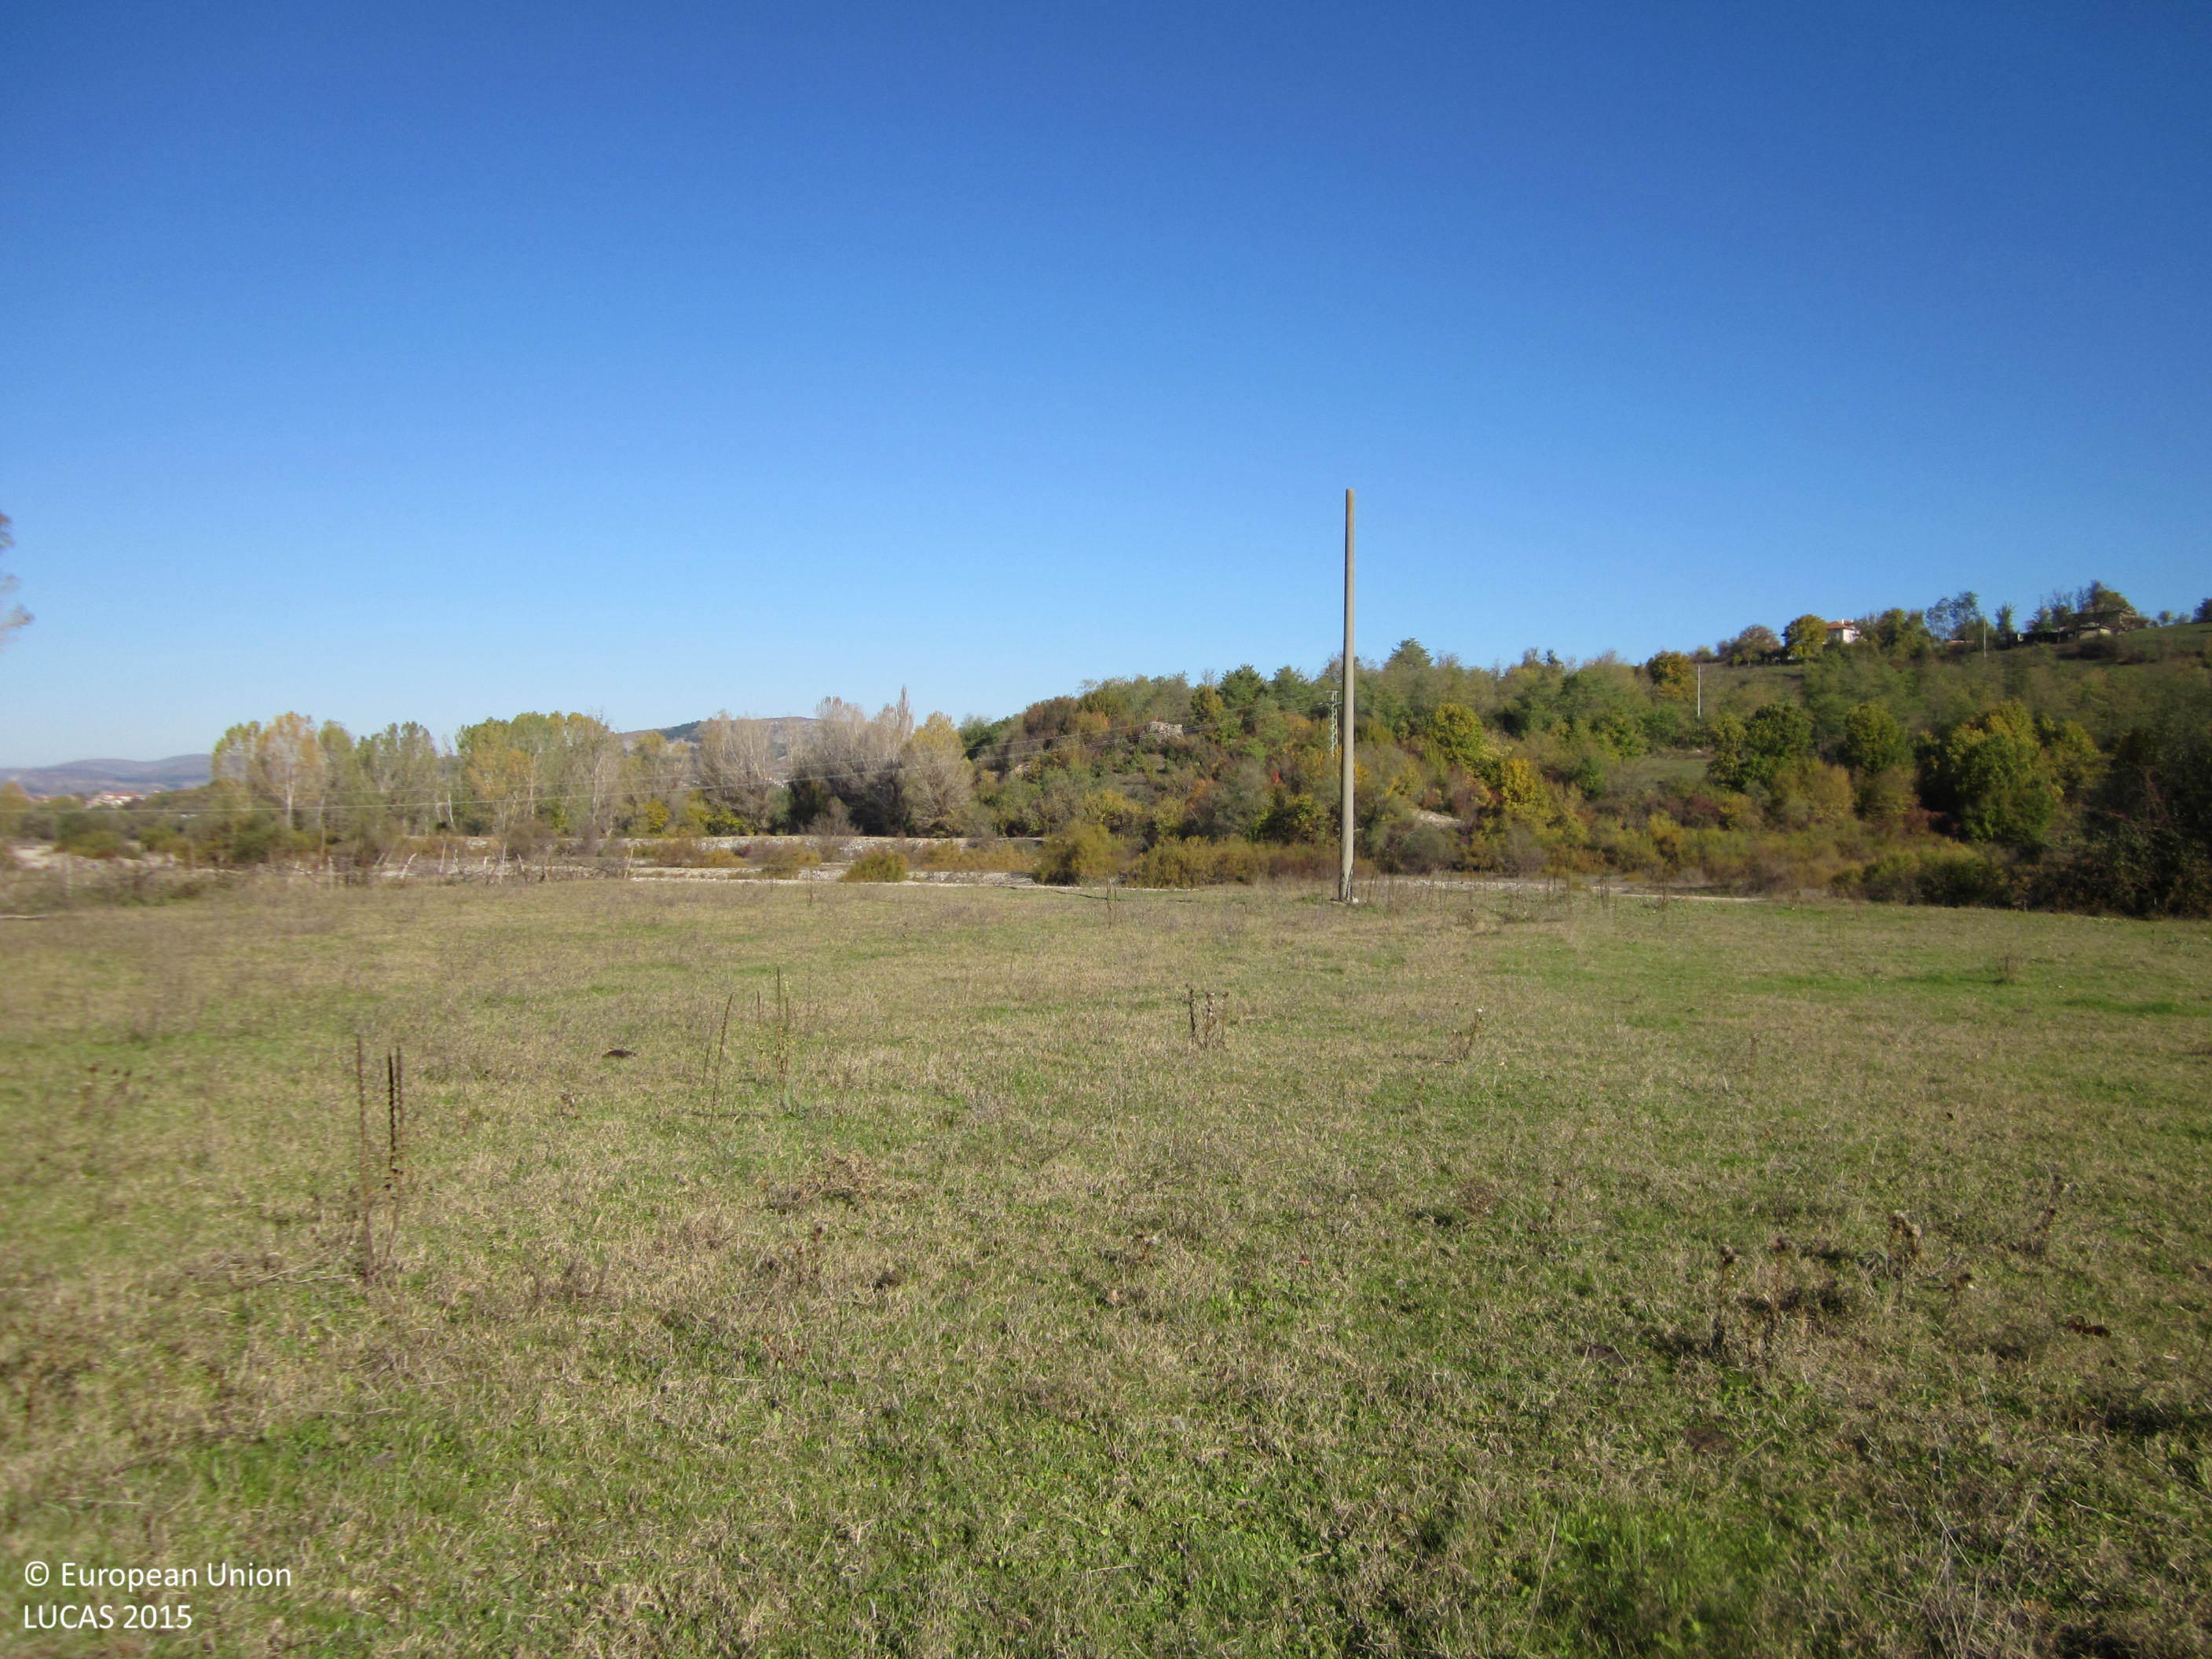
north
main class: Grassland
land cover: Grassland without tree/shrub cover
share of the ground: > 75 %
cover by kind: herbaceous plants 100 %
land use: Agriculture (excluding fallow land and kitchen gardens)
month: November
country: BG
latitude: 41.4424
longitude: 25.6797
